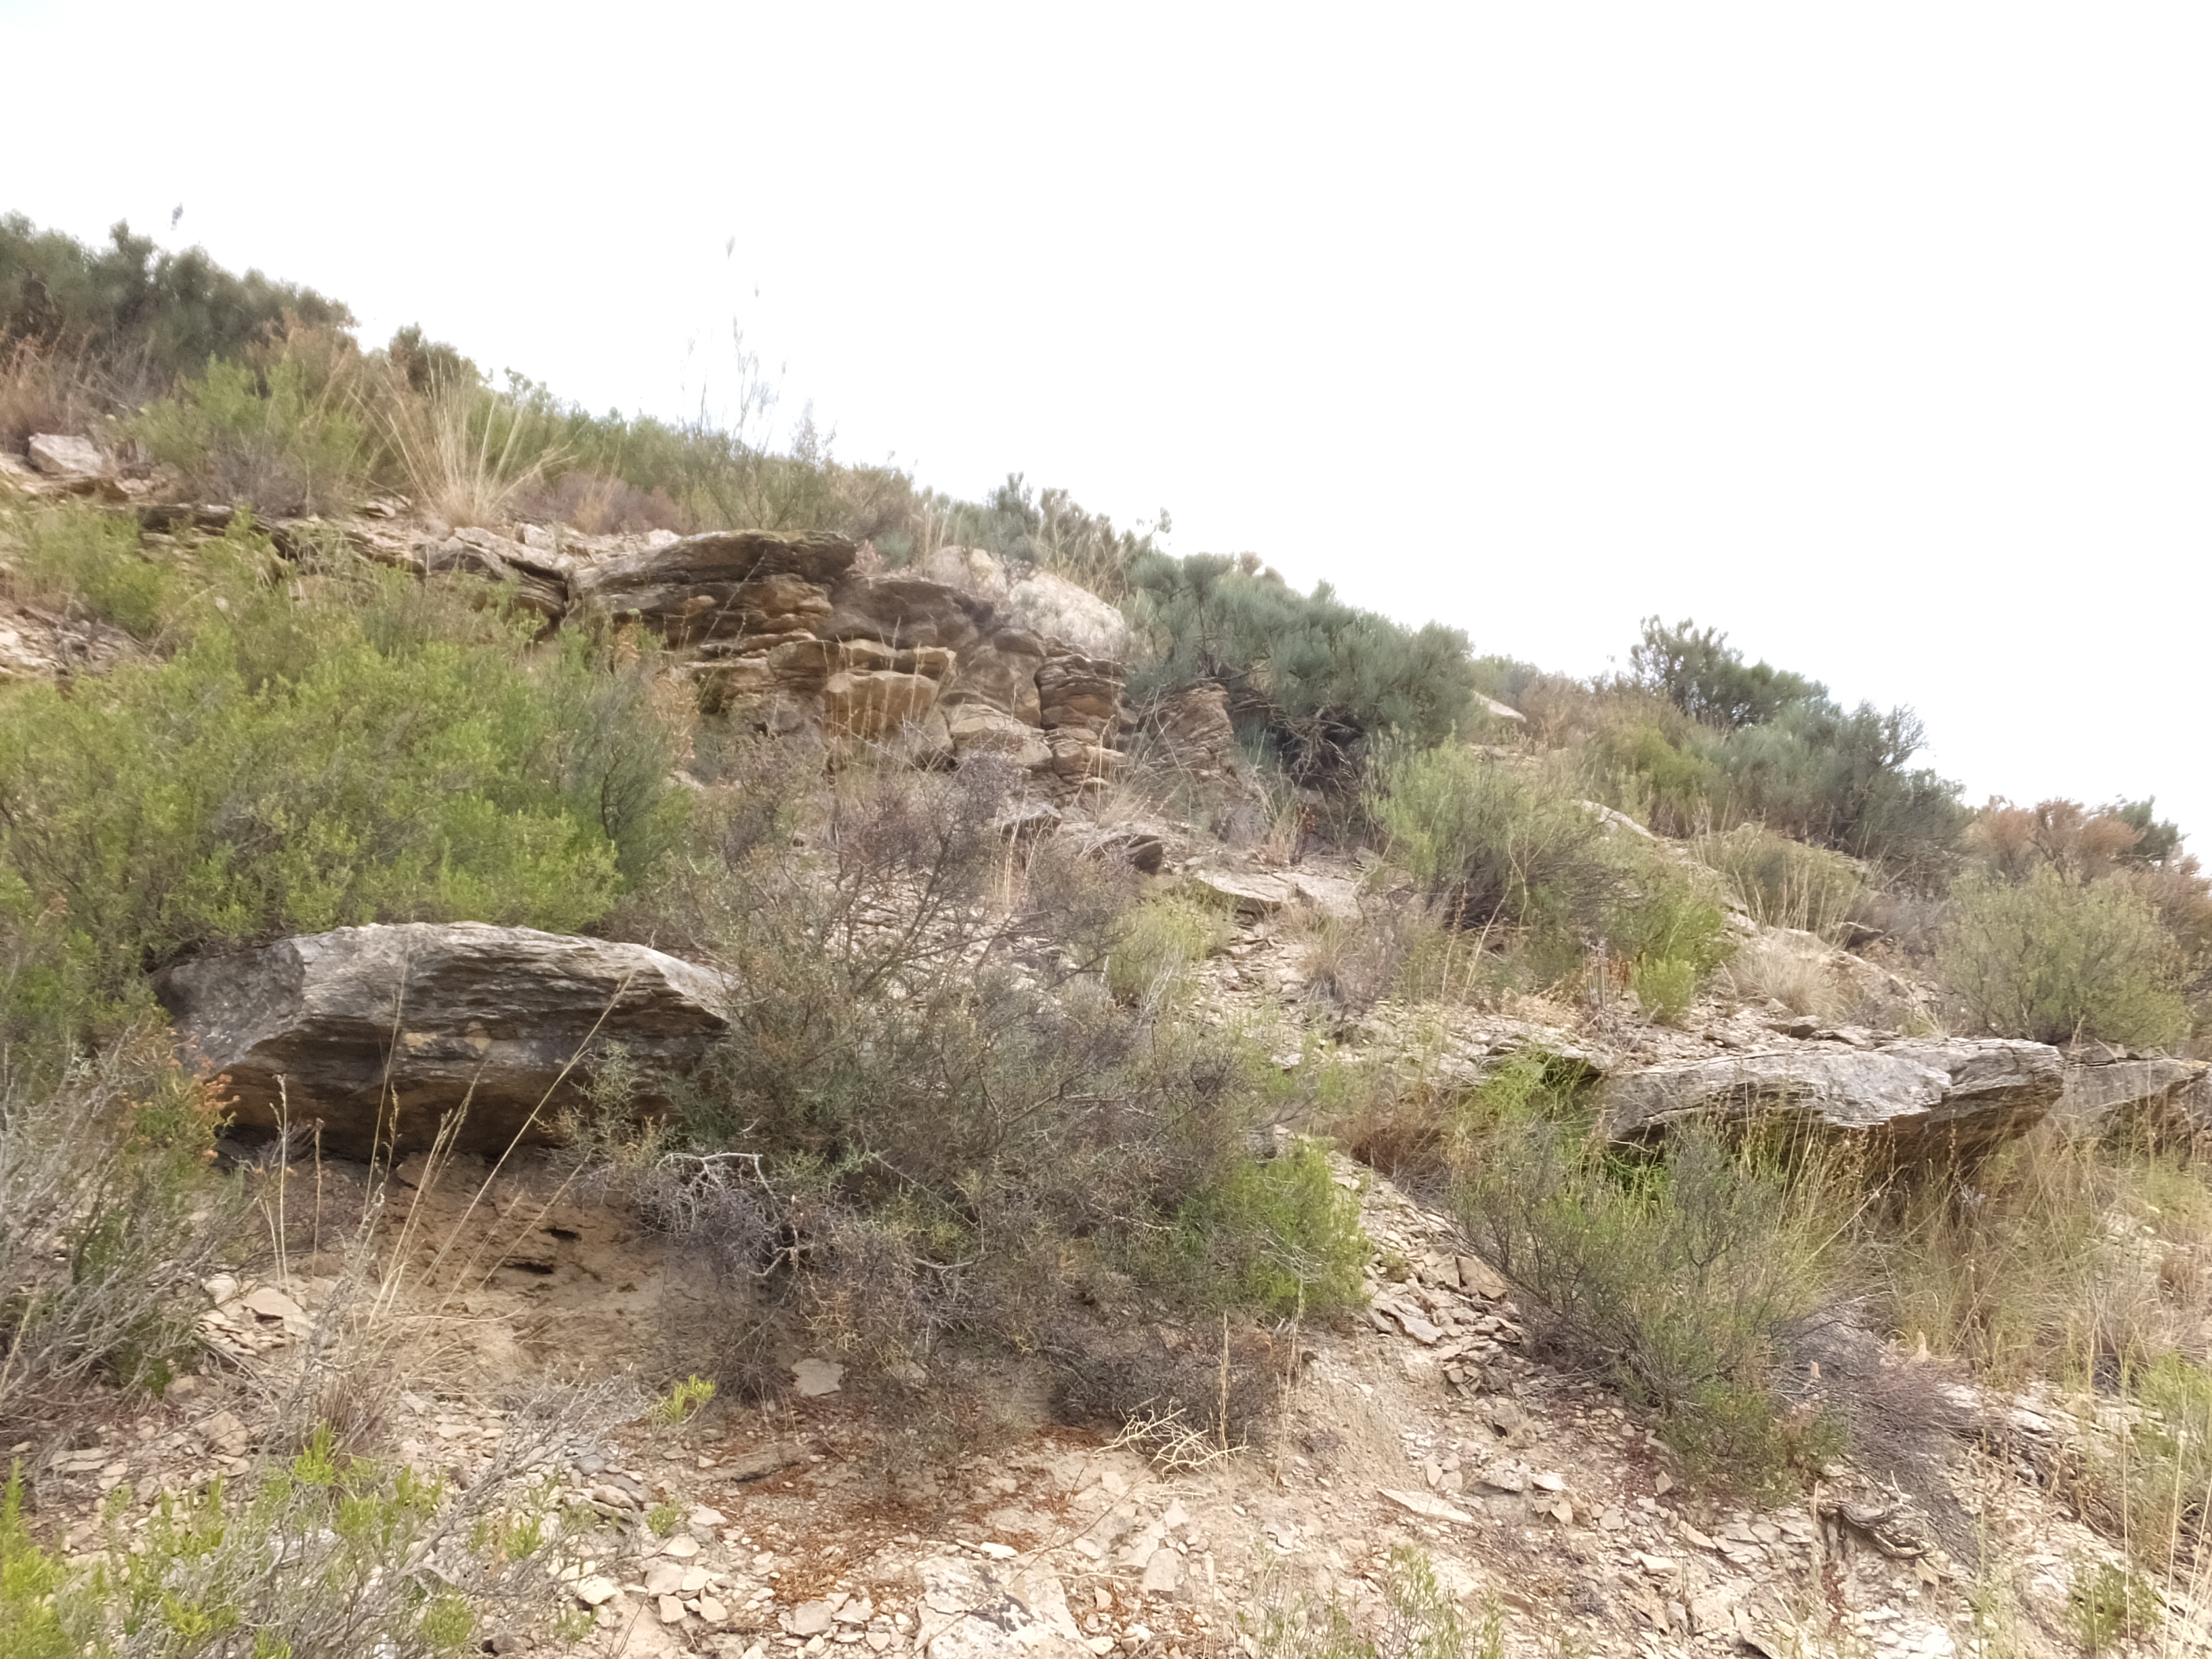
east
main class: Shrubland
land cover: Shrubland without tree cover
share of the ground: > 75 %
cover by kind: shrubs 45 %, herbaceous plants 45 %, unconsolidated bare surface 10 %
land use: Semi-natural and natural areas not in use
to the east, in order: Shrubland without tree cover; Tracks; Fences; Tracks; Shrubland without tree cover; Other fruit trees and berries; Artificial constructions in urban areas; Tracks; Lines of trees; Other fruit trees and berries
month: June
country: ES
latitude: 41.4268
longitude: 0.3312
